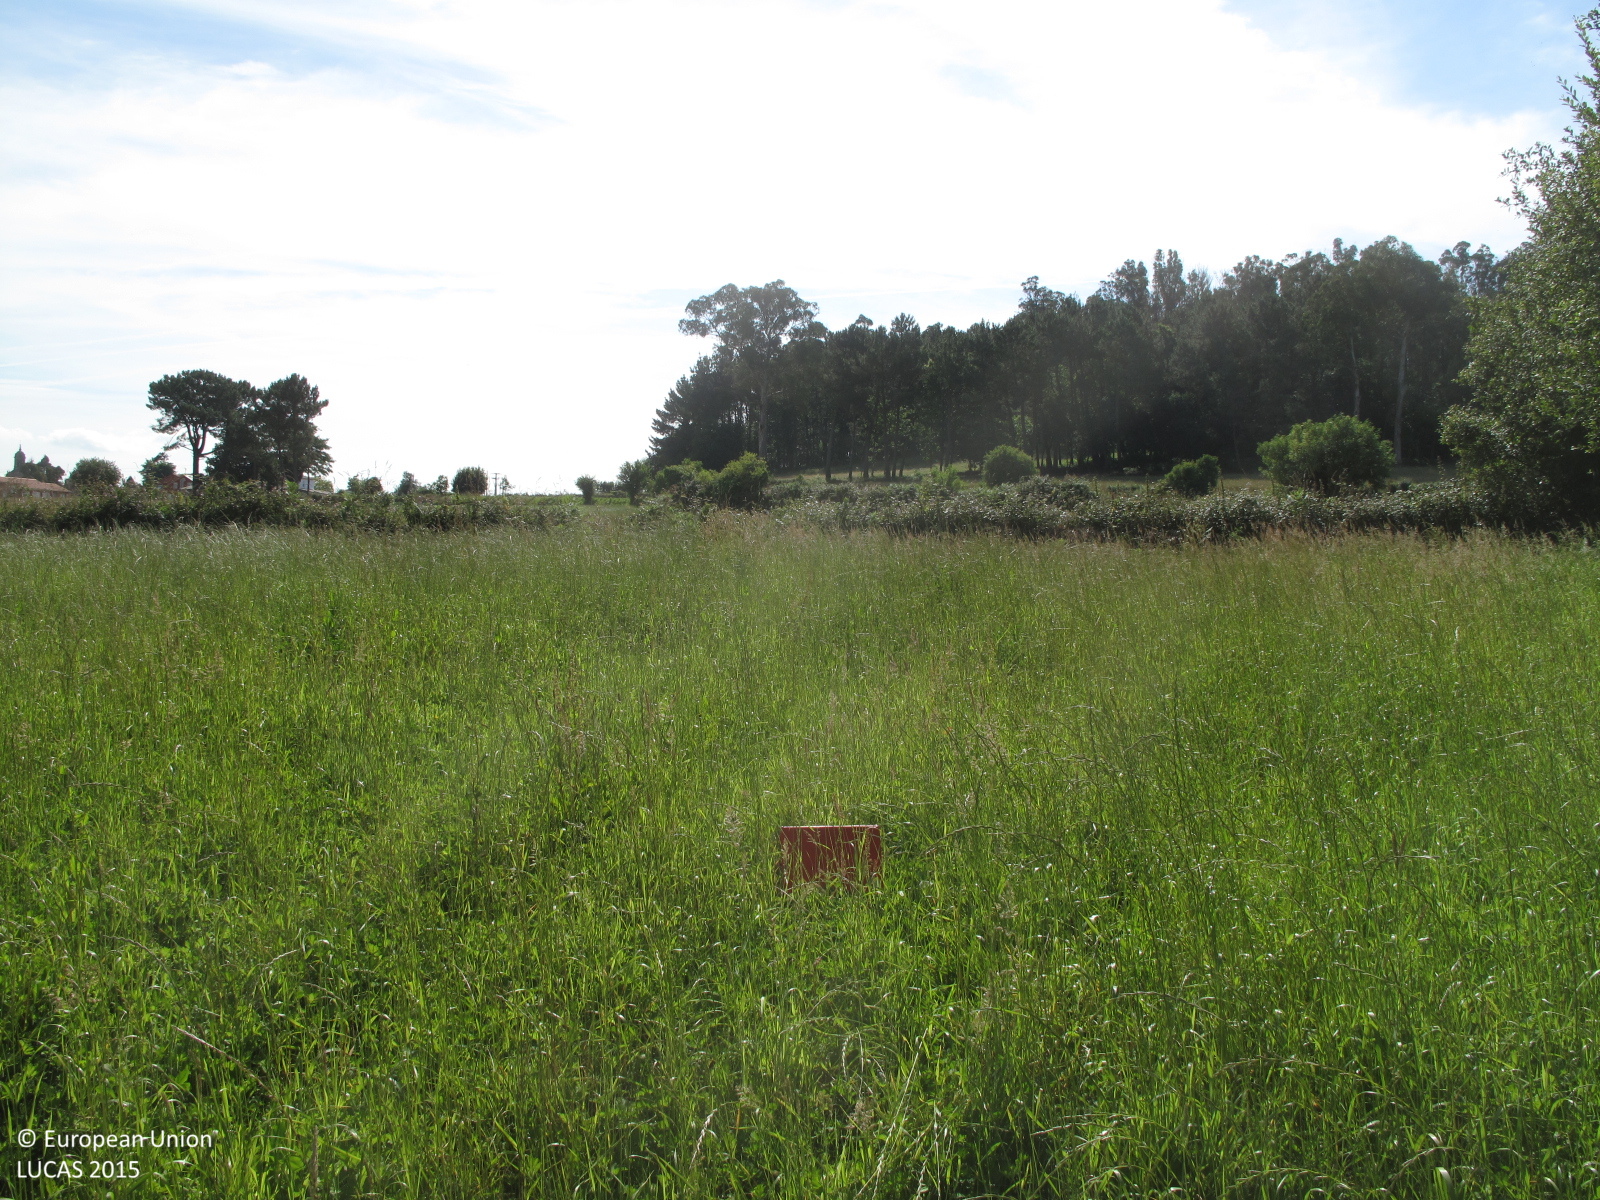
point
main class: Grassland
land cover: Grassland without tree/shrub cover
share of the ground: > 75 %
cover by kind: herbaceous plants 100 %
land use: Agriculture (excluding fallow land and kitchen gardens)
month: July
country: ES
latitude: 43.1982
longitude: -8.7346
